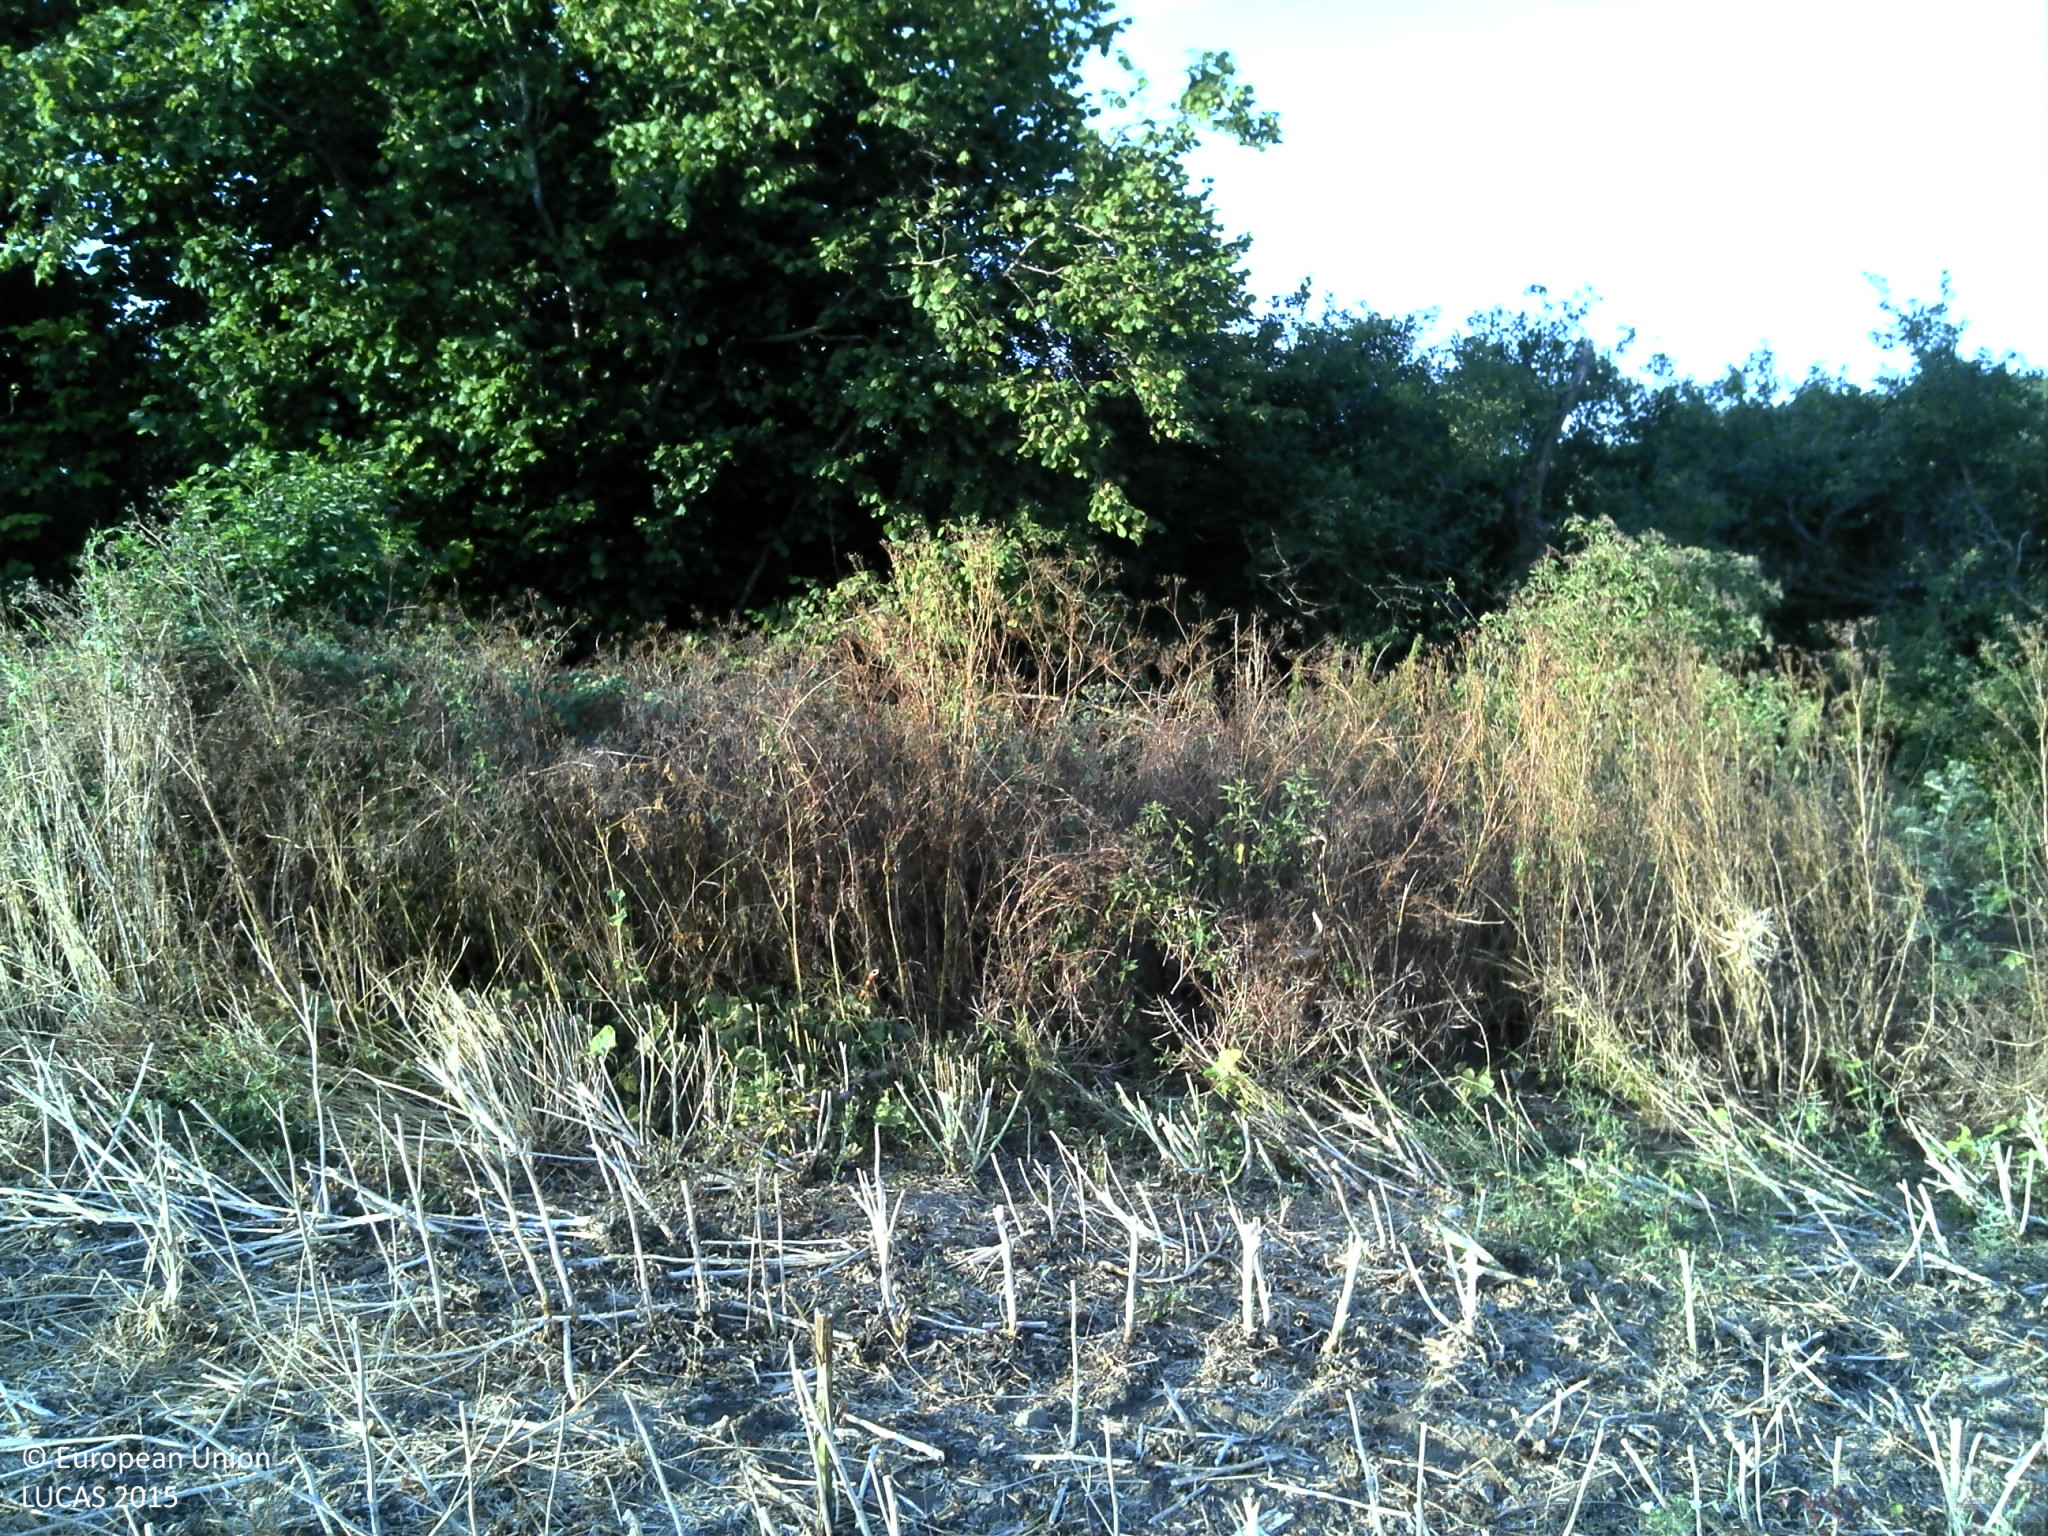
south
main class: Cropland
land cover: Rape and turnip rape
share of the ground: < 10 %
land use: Agriculture (excluding fallow land and kitchen gardens)
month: July
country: FR
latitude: 48.3178
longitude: 6.1300
